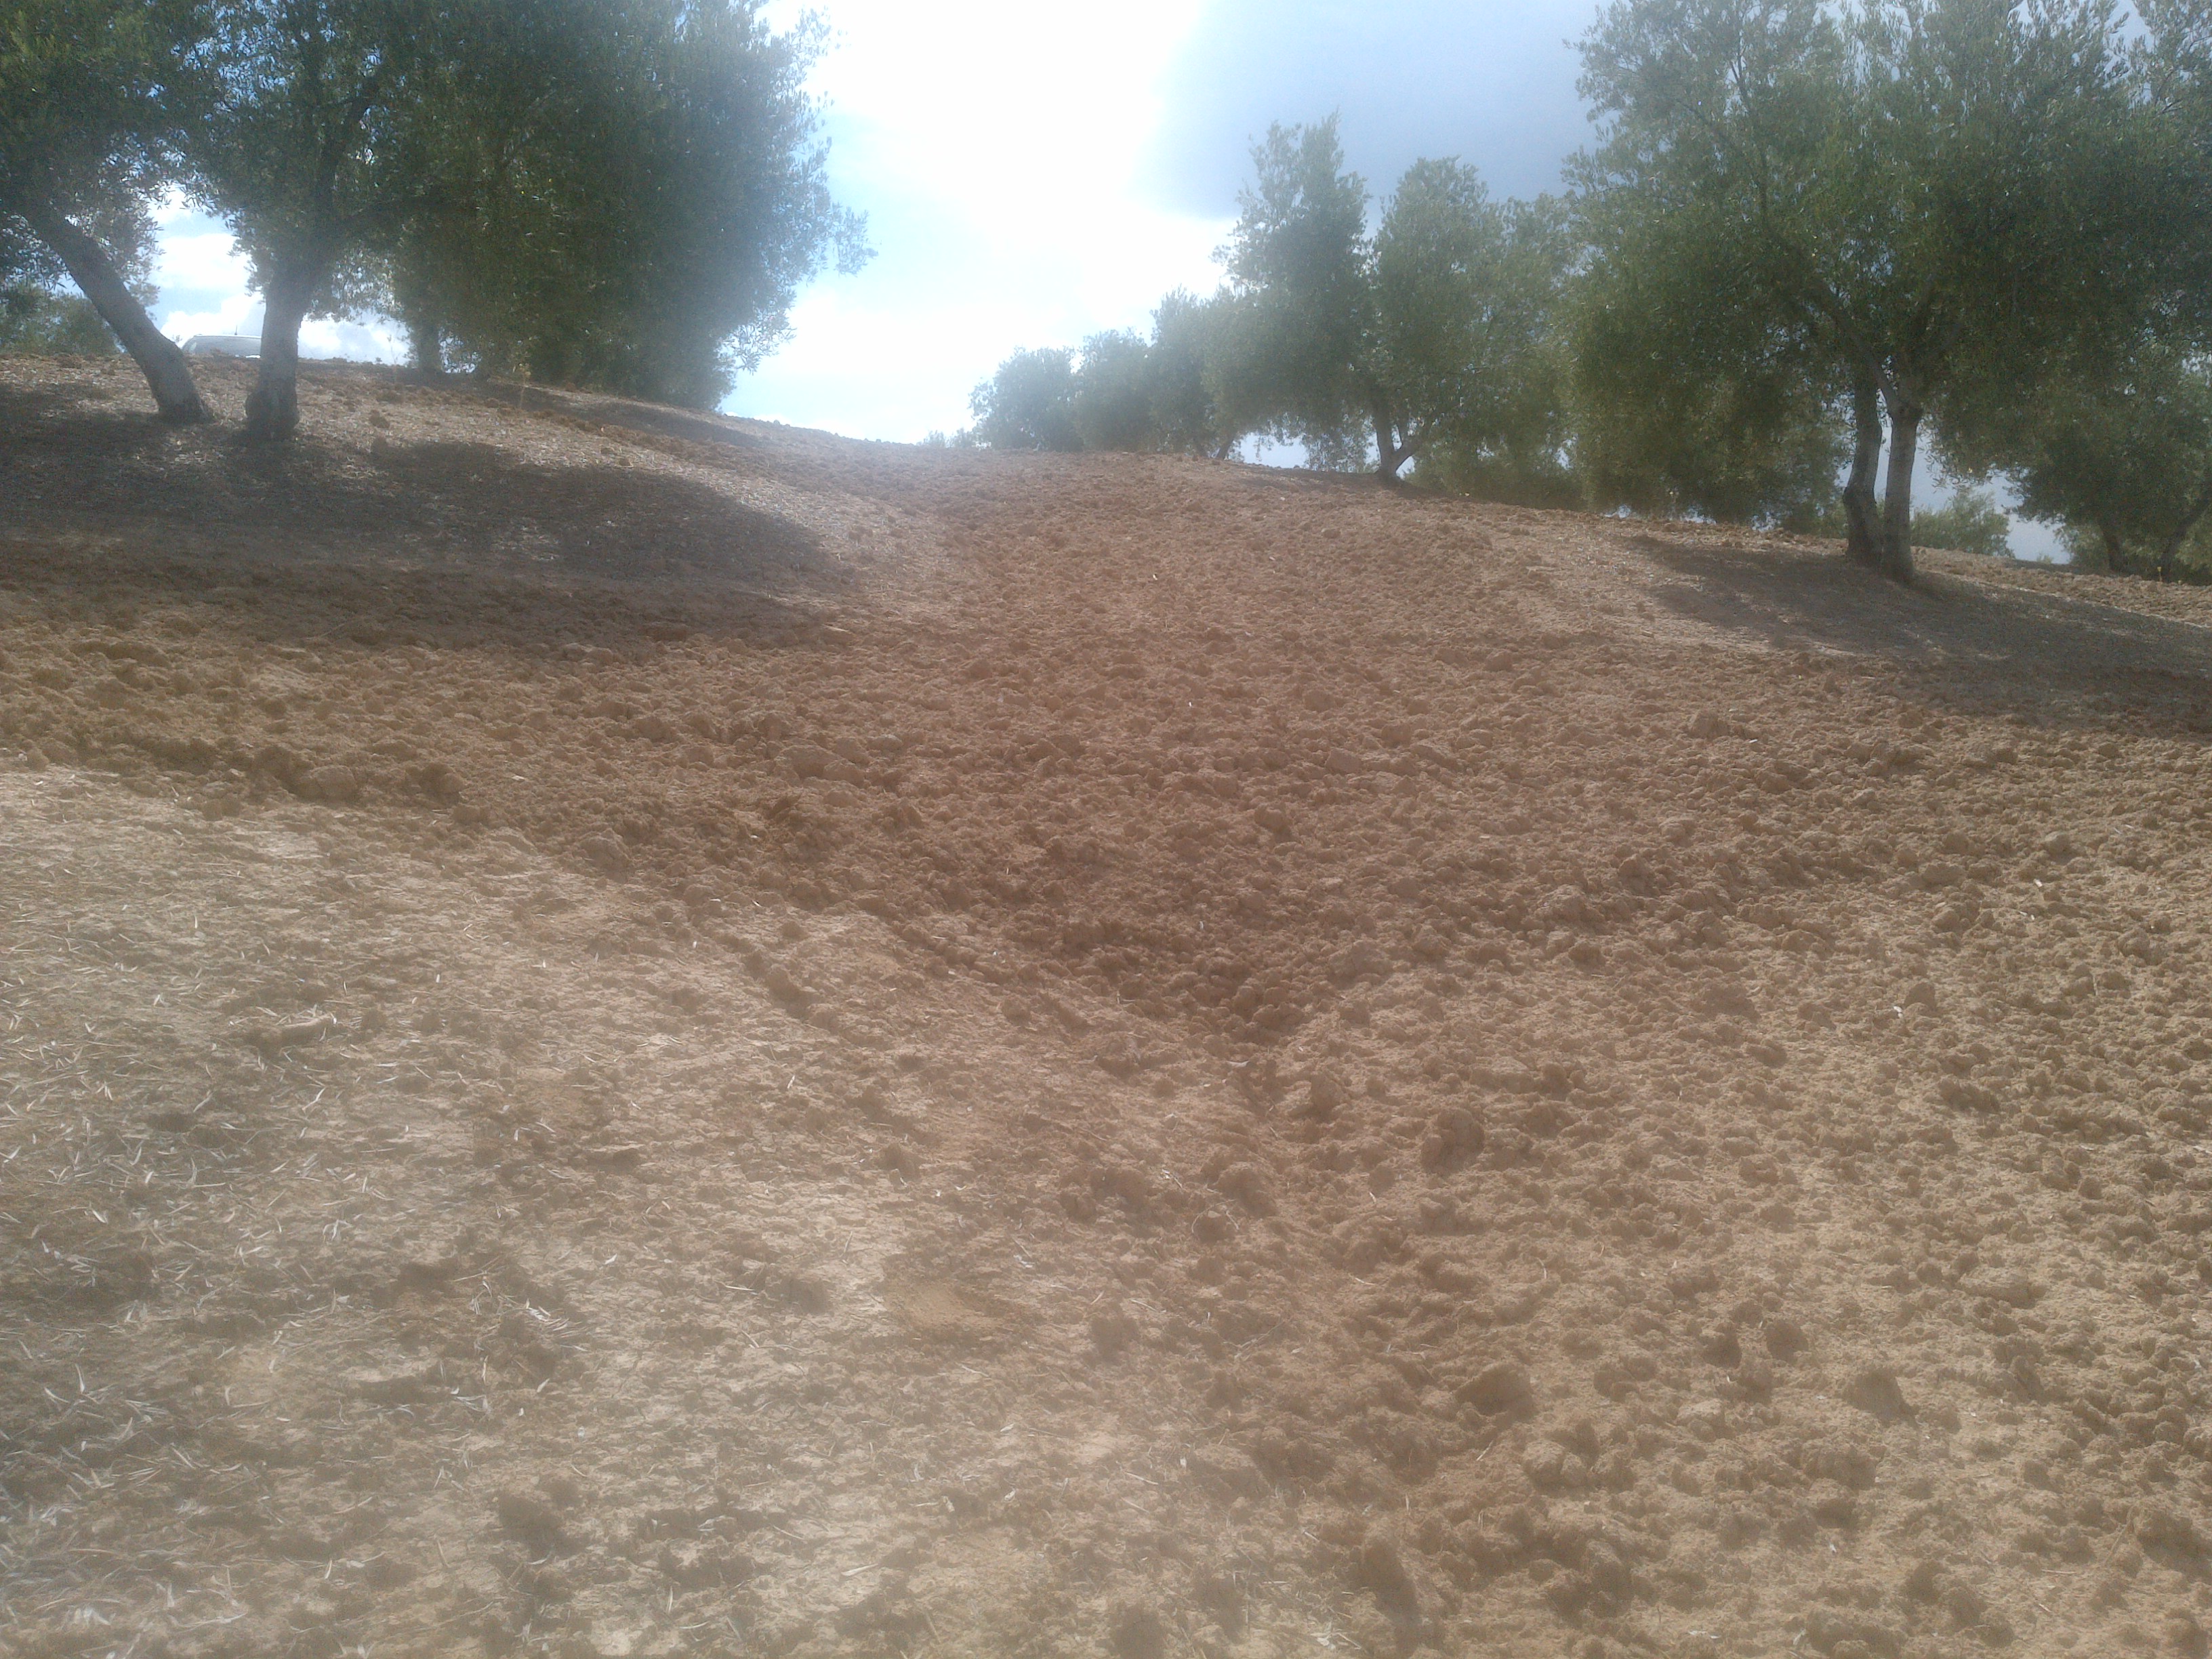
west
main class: Cropland
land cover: Olive groves
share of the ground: 50 - 75 %
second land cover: Other bare soil
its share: > 75 %
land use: Agriculture (excluding fallow land and kitchen gardens)
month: June
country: ES
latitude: 37.7706
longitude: -4.2534
